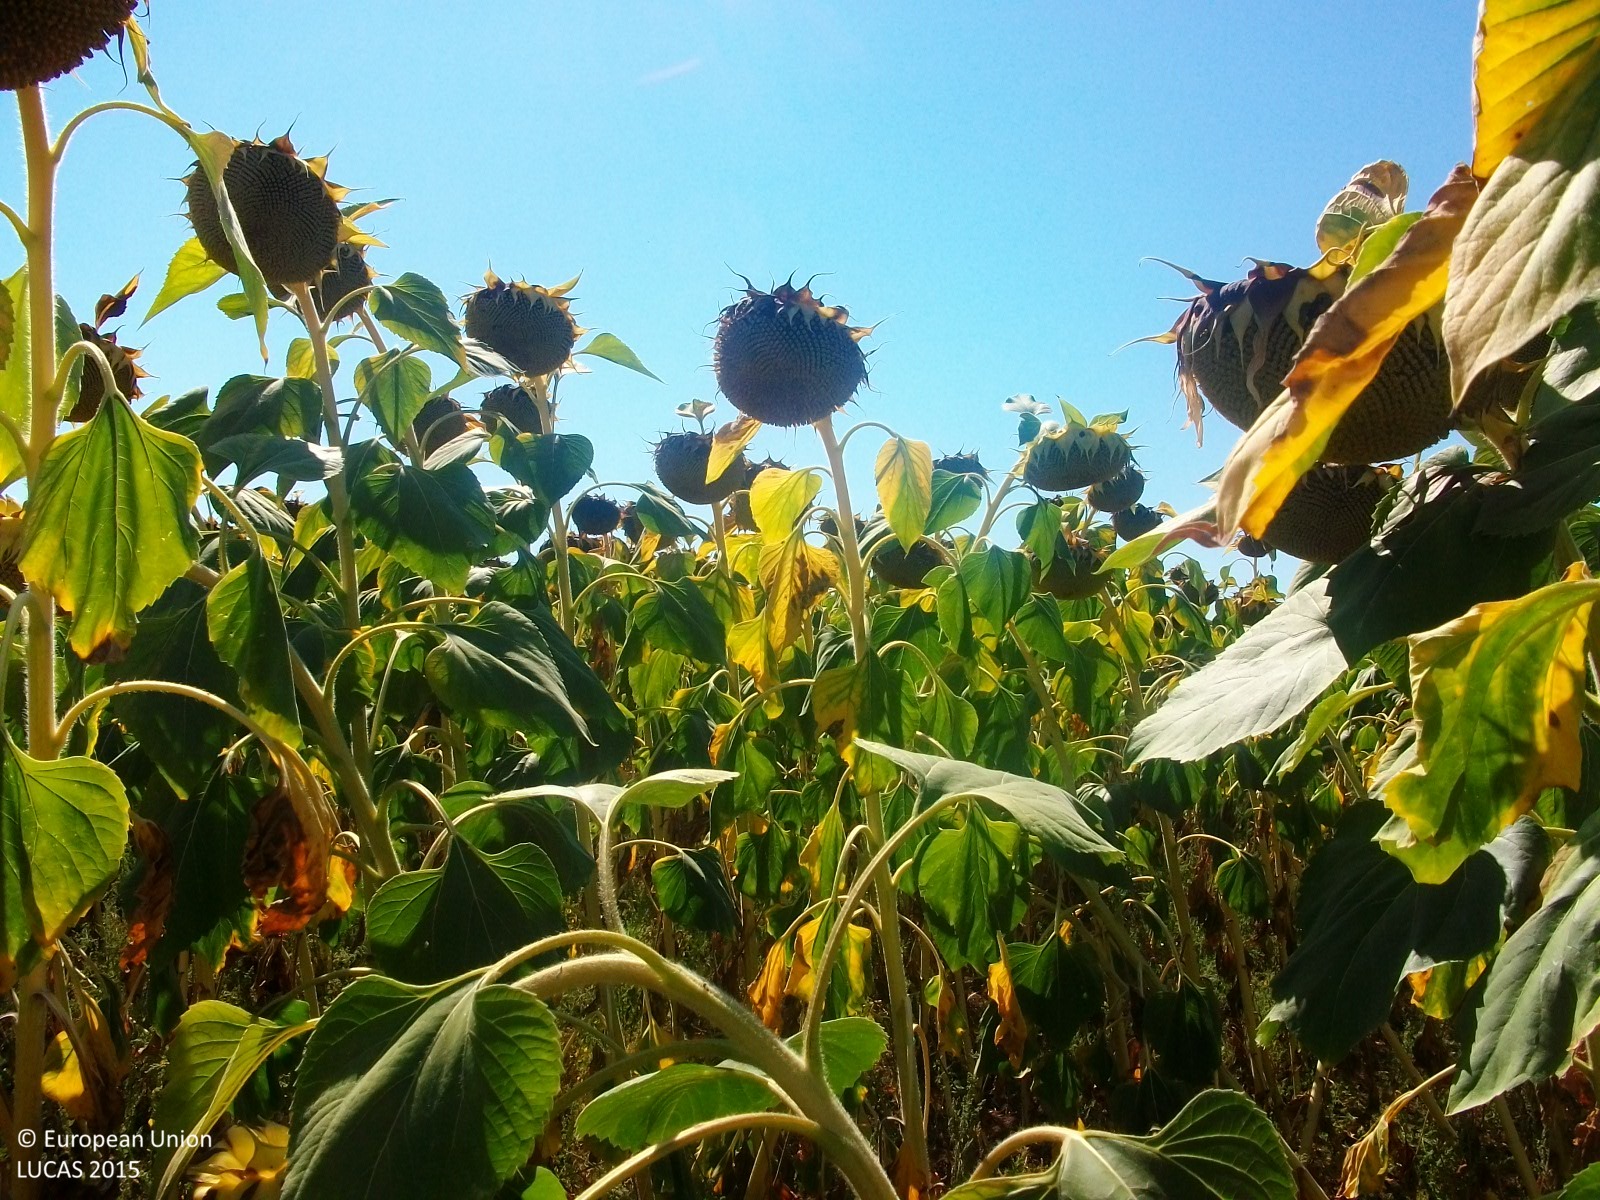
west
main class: Cropland
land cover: Sunflower
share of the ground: > 75 %
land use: Agriculture (excluding fallow land and kitchen gardens)
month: July
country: GR
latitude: 41.4139
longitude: 26.3079
